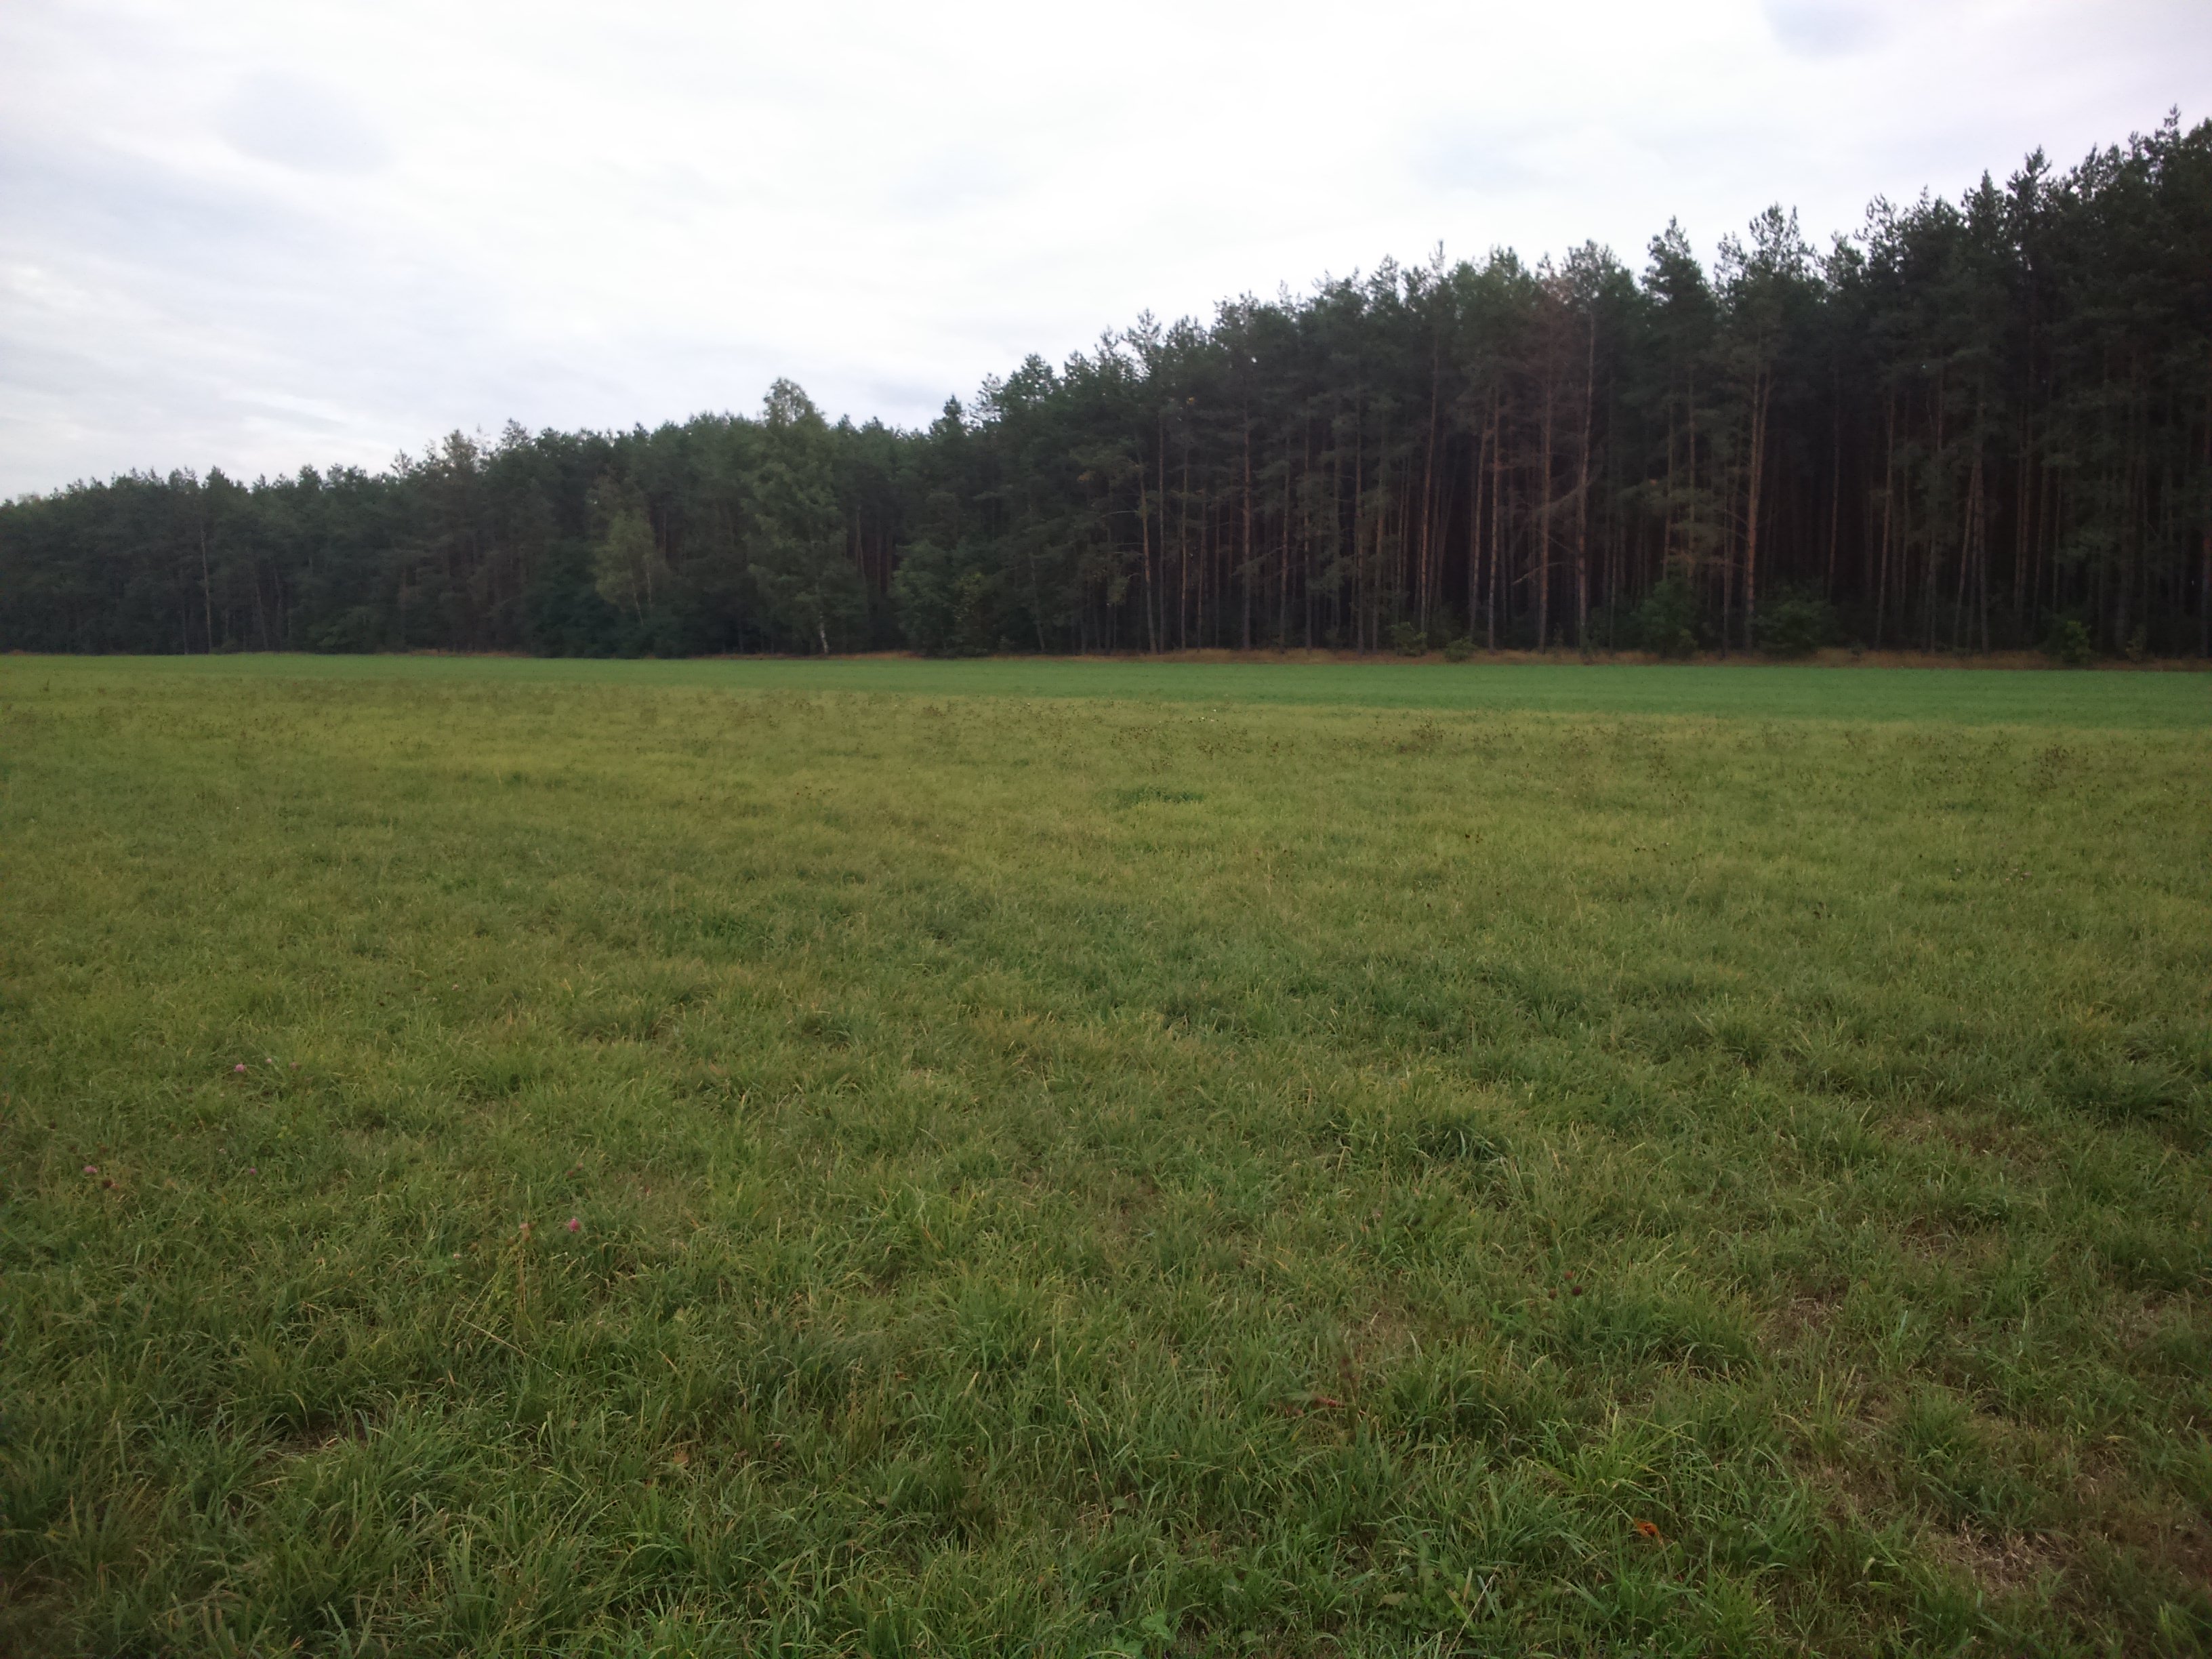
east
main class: Grassland
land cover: Grassland without tree/shrub cover
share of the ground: > 75 %
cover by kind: herbaceous plants 100 %
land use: Agriculture (excluding fallow land and kitchen gardens)
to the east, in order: Grassland without tree/shrub cover; Tracks; Pine dominated coniferous woodland; Broadleaved woodland
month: September
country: PL
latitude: 52.2690
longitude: 22.0609
